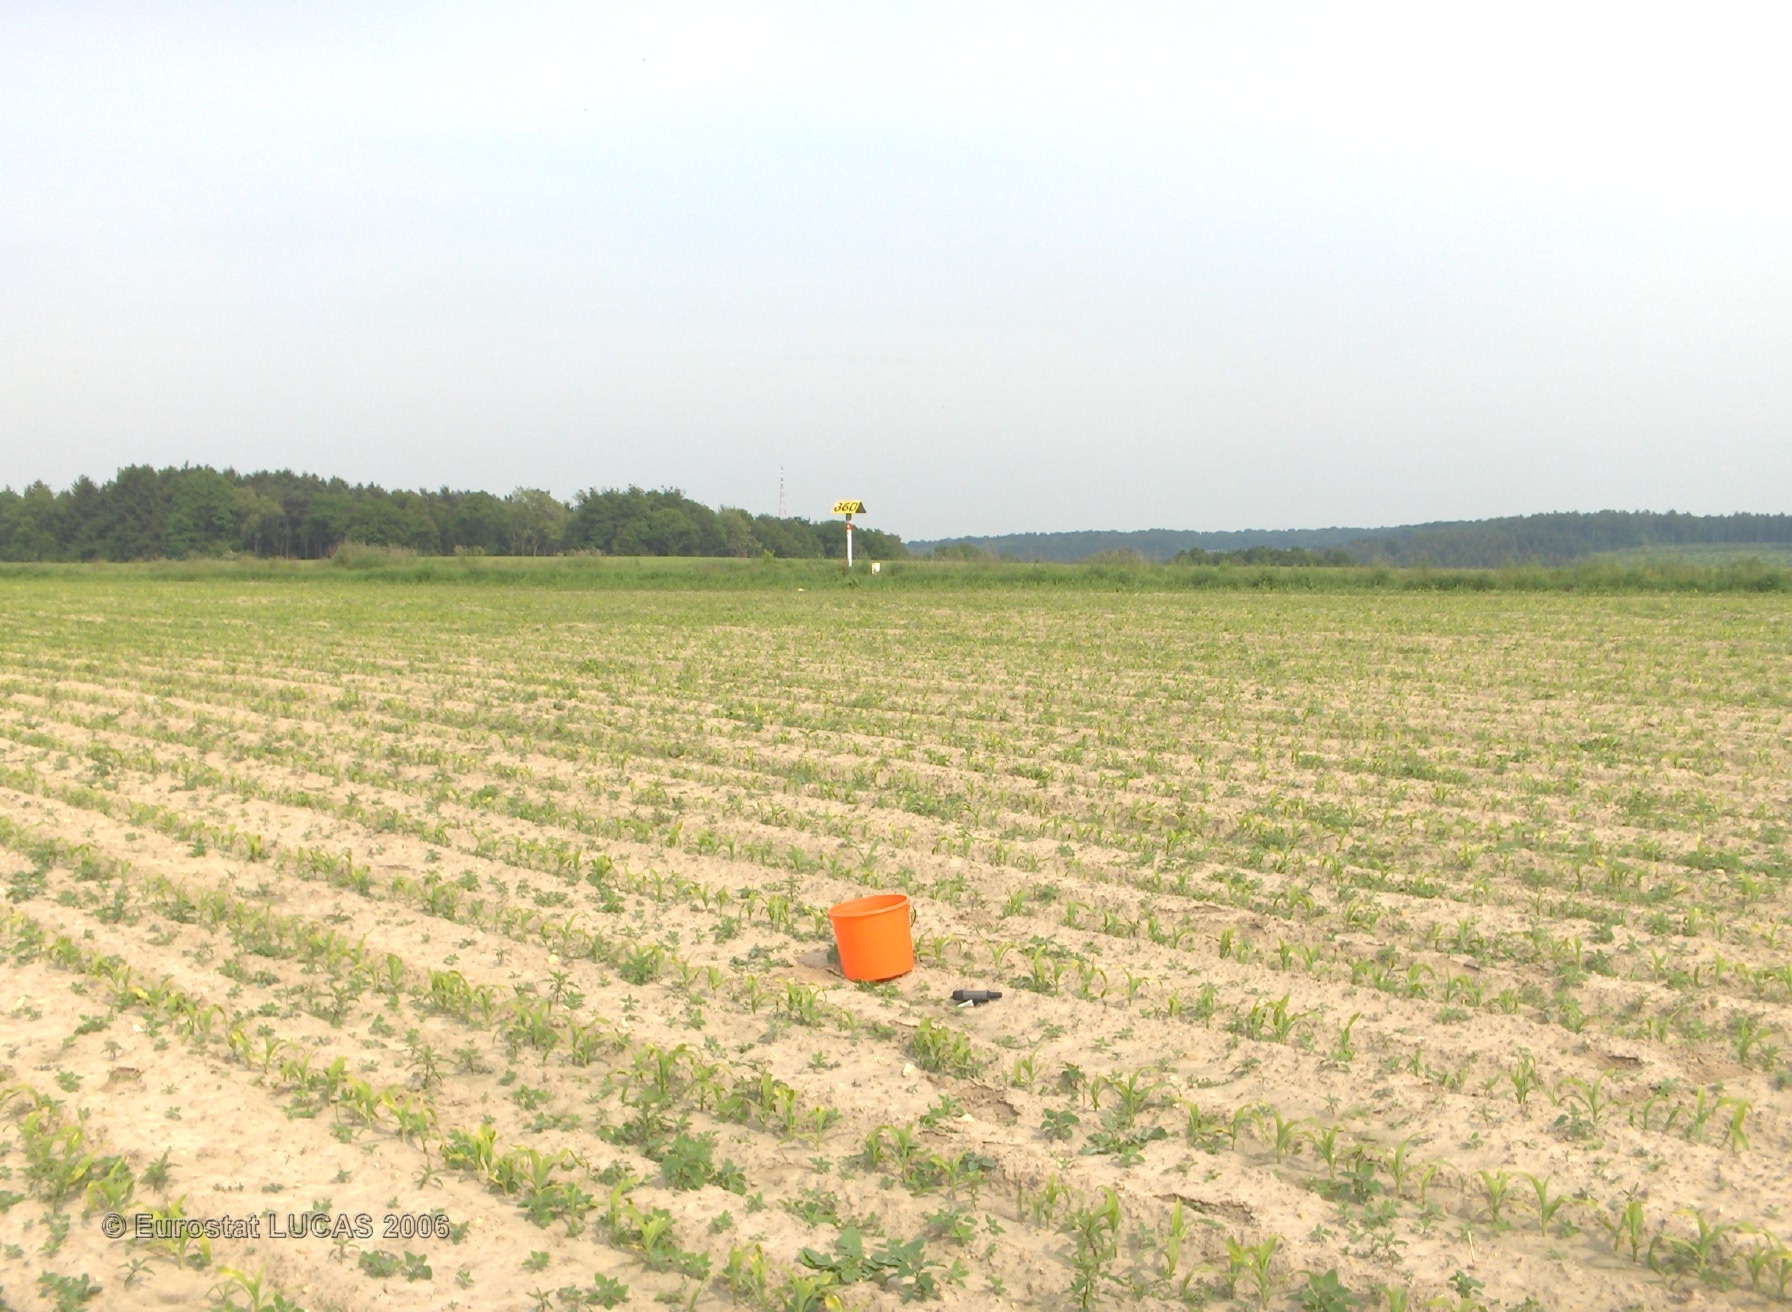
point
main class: Cropland
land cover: Maize
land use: Agriculture (excluding fallow land and kitchen gardens)
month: May
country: BE
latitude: 50.6115
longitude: 4.5269
